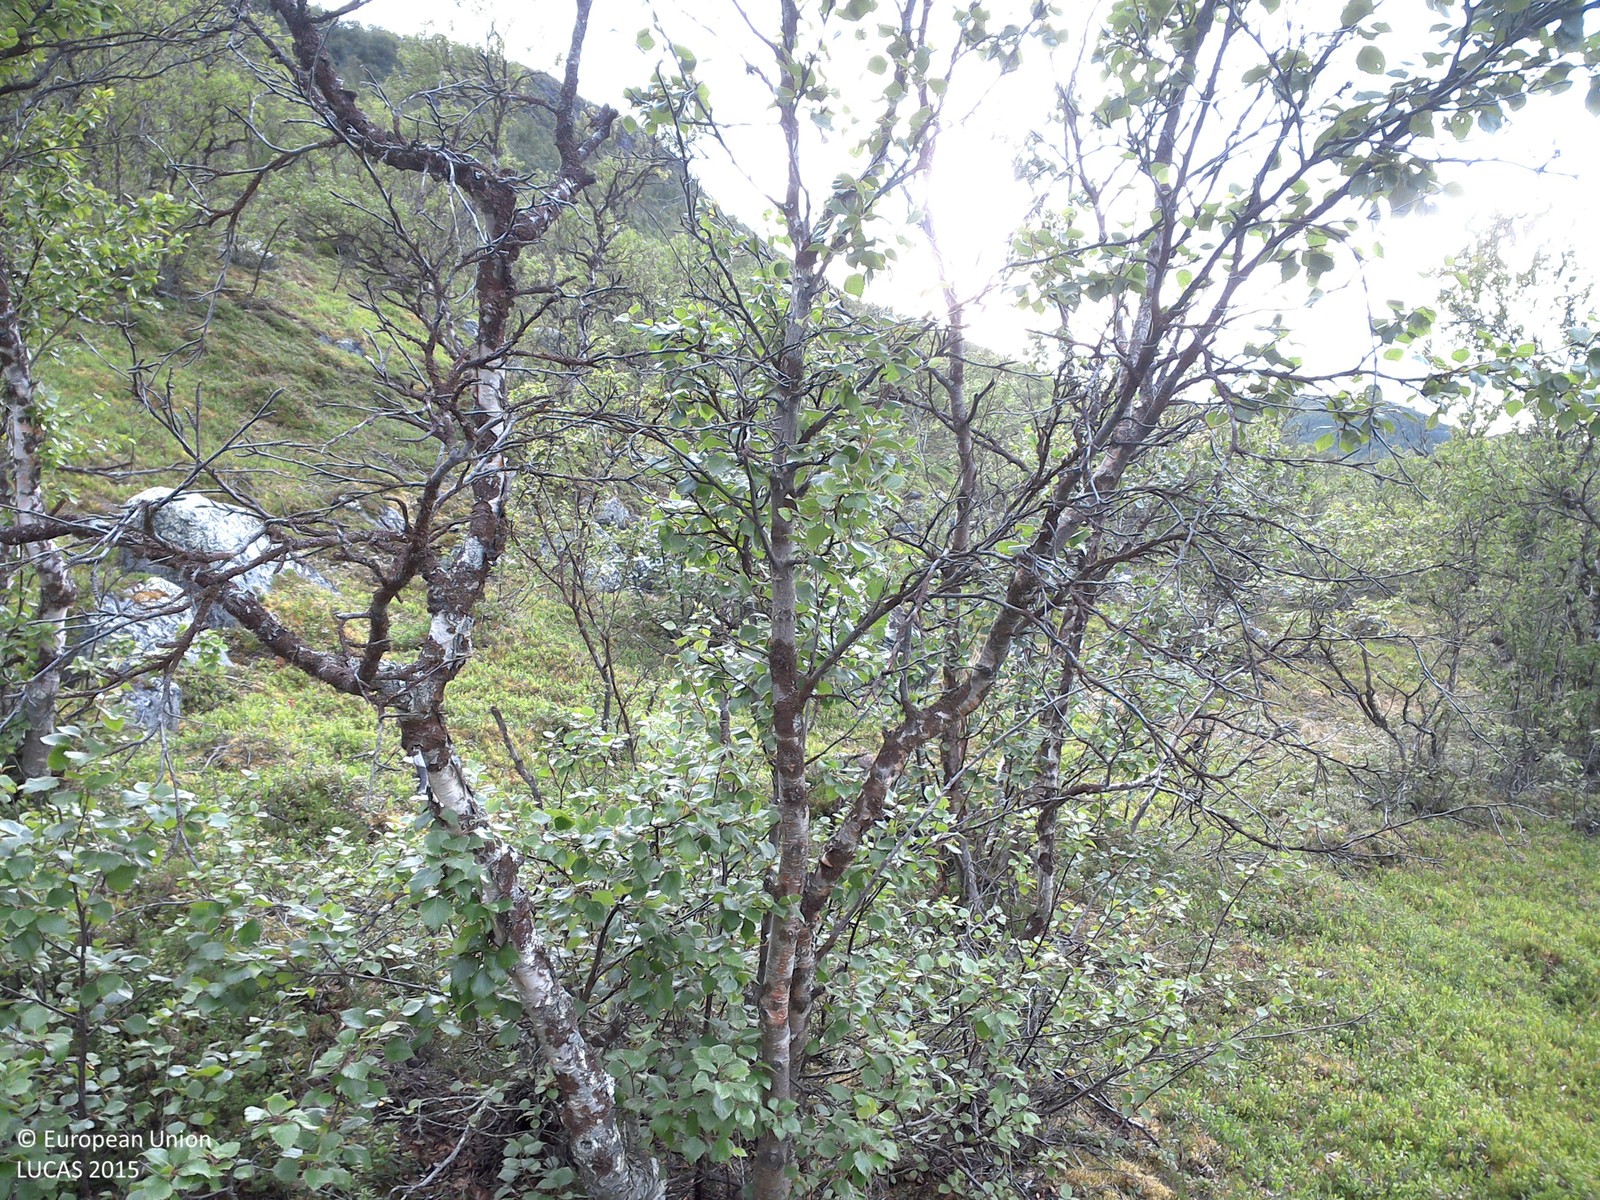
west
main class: Woodland
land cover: Broadleaved woodland
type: boreal forest
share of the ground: 10 - 25 %
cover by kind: shrubs 60 %, broadleaved forest trees 20 %, lichens and mosses 20 %
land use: Forestry
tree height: < 5 m
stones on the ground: > 50 %
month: August
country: SE
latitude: 68.2360
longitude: 19.5276
